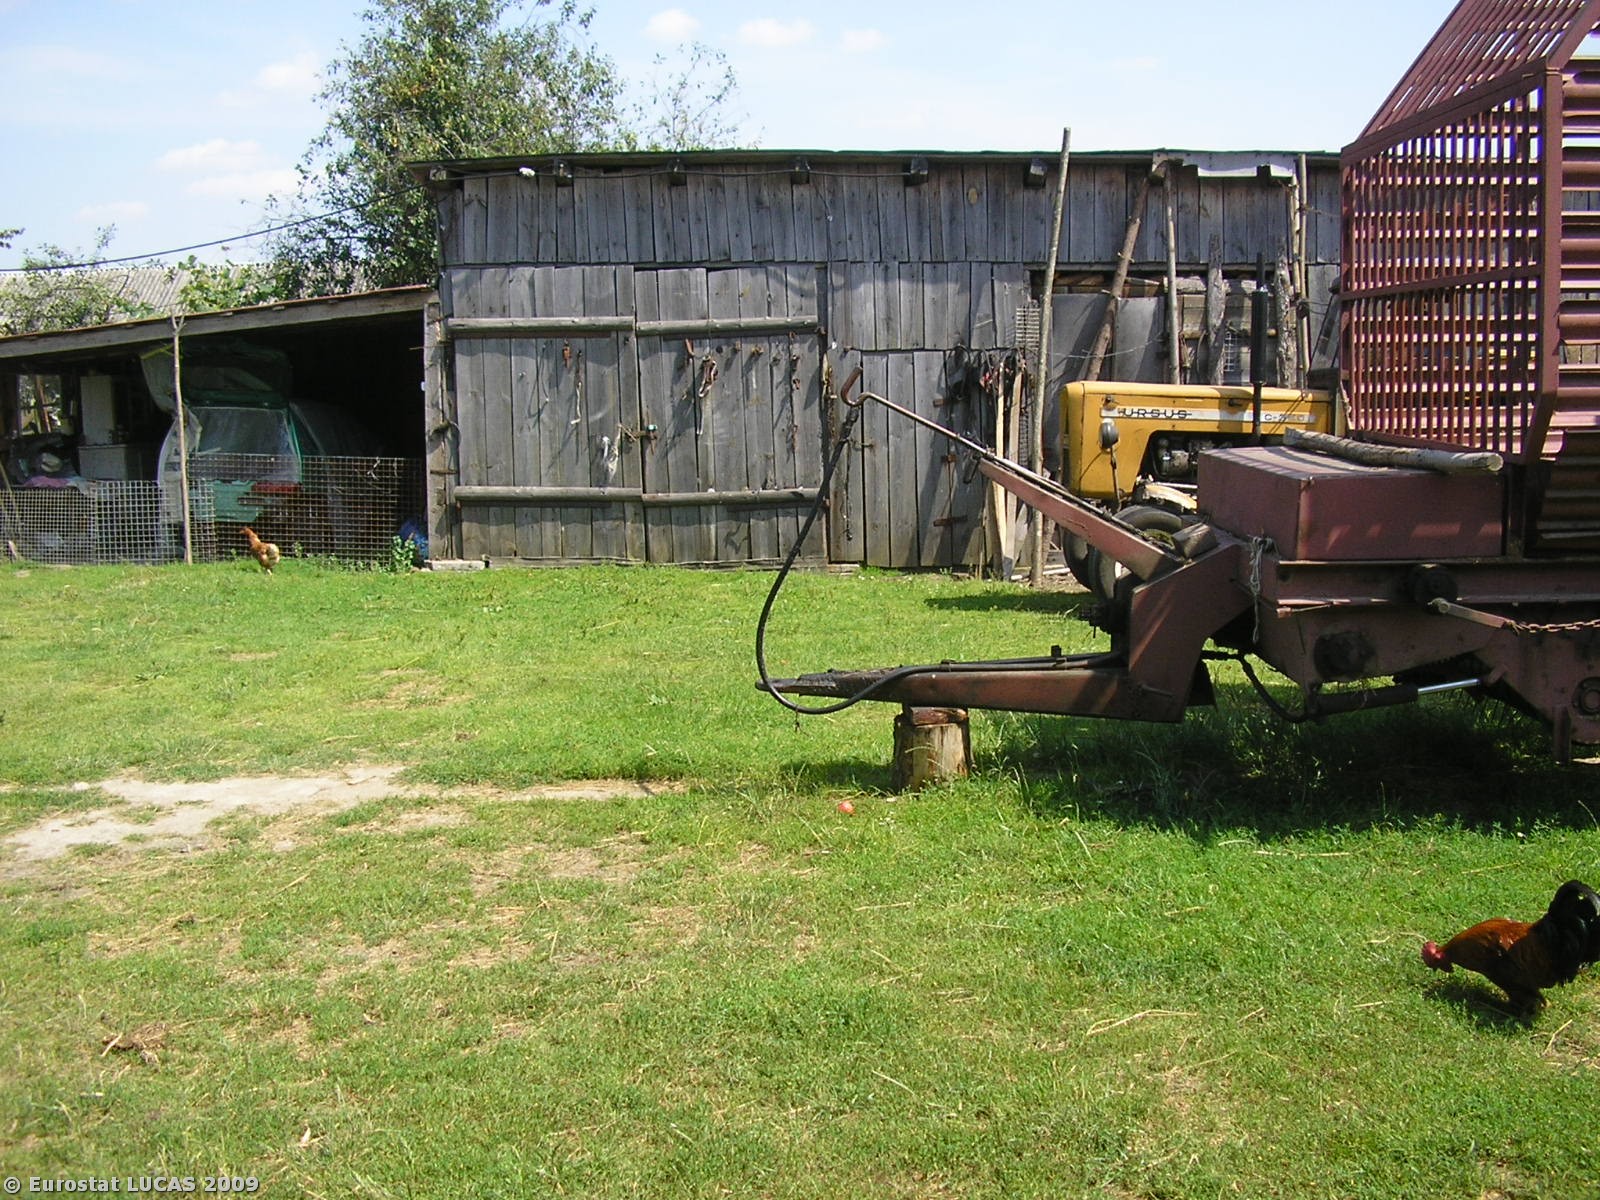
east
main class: Grassland
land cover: Grassland without tree/shrub cover
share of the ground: > 75 %
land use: Residential
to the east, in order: Grassland without tree/shrub cover; Artificial constructions in urban areas; Fences; Common wheat; Grassland without tree/shrub cover; Fences; Artificial constructions in urban areas; Fences; Maize; Grass margins; Oats; Grass margins; Common wheat; Rye
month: July
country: PL
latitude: 52.0359
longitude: 22.2047
